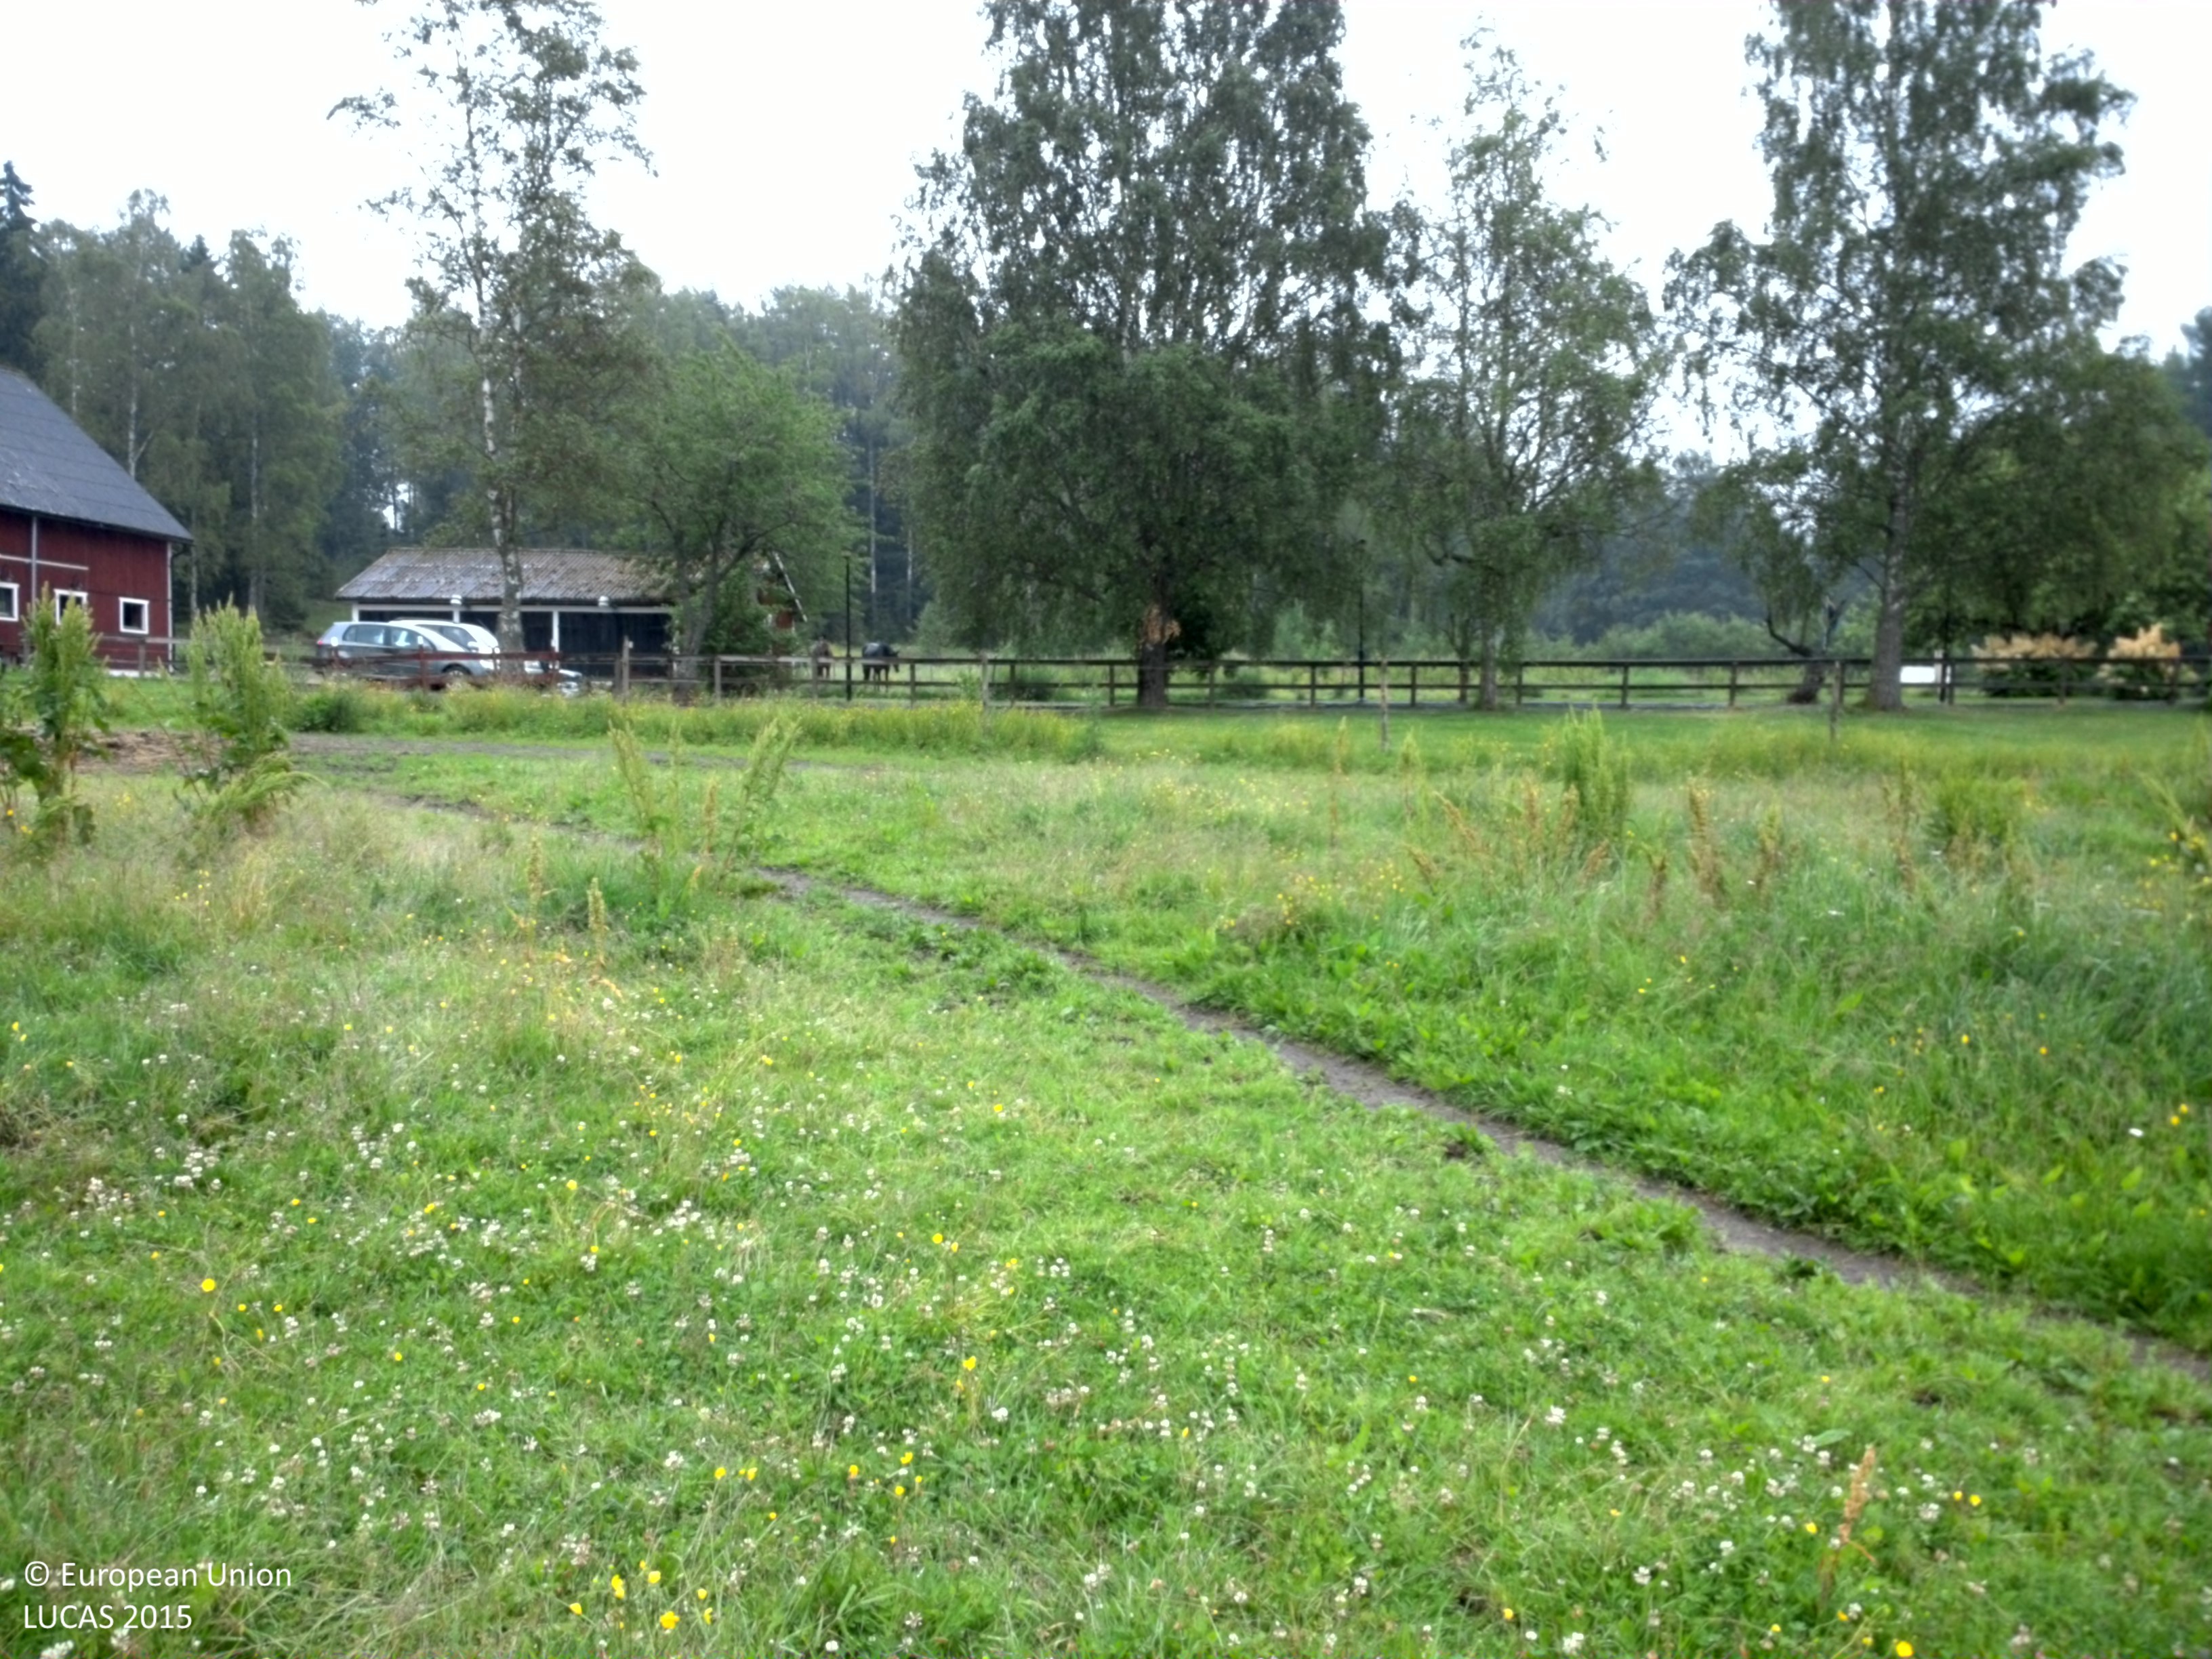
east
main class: Grassland
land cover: Grassland without tree/shrub cover
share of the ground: > 75 %
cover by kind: herbaceous plants 100 %
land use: Agriculture (excluding fallow land and kitchen gardens)
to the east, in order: Grassland without tree/shrub cover; Artificial constructions in urban areas; Grassland without tree/shrub cover; Fences; Paved roads, cycling and walking lanes; Fences; Grassland without tree/shrub cover; Fences; Pine dominated mixed woodland; Fences; Grassland without tree/shrub cover; Spruce dominated mixed woodland; Grassland without tree/shrub cover
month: July
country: SE
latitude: 58.8526
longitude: 14.8634
